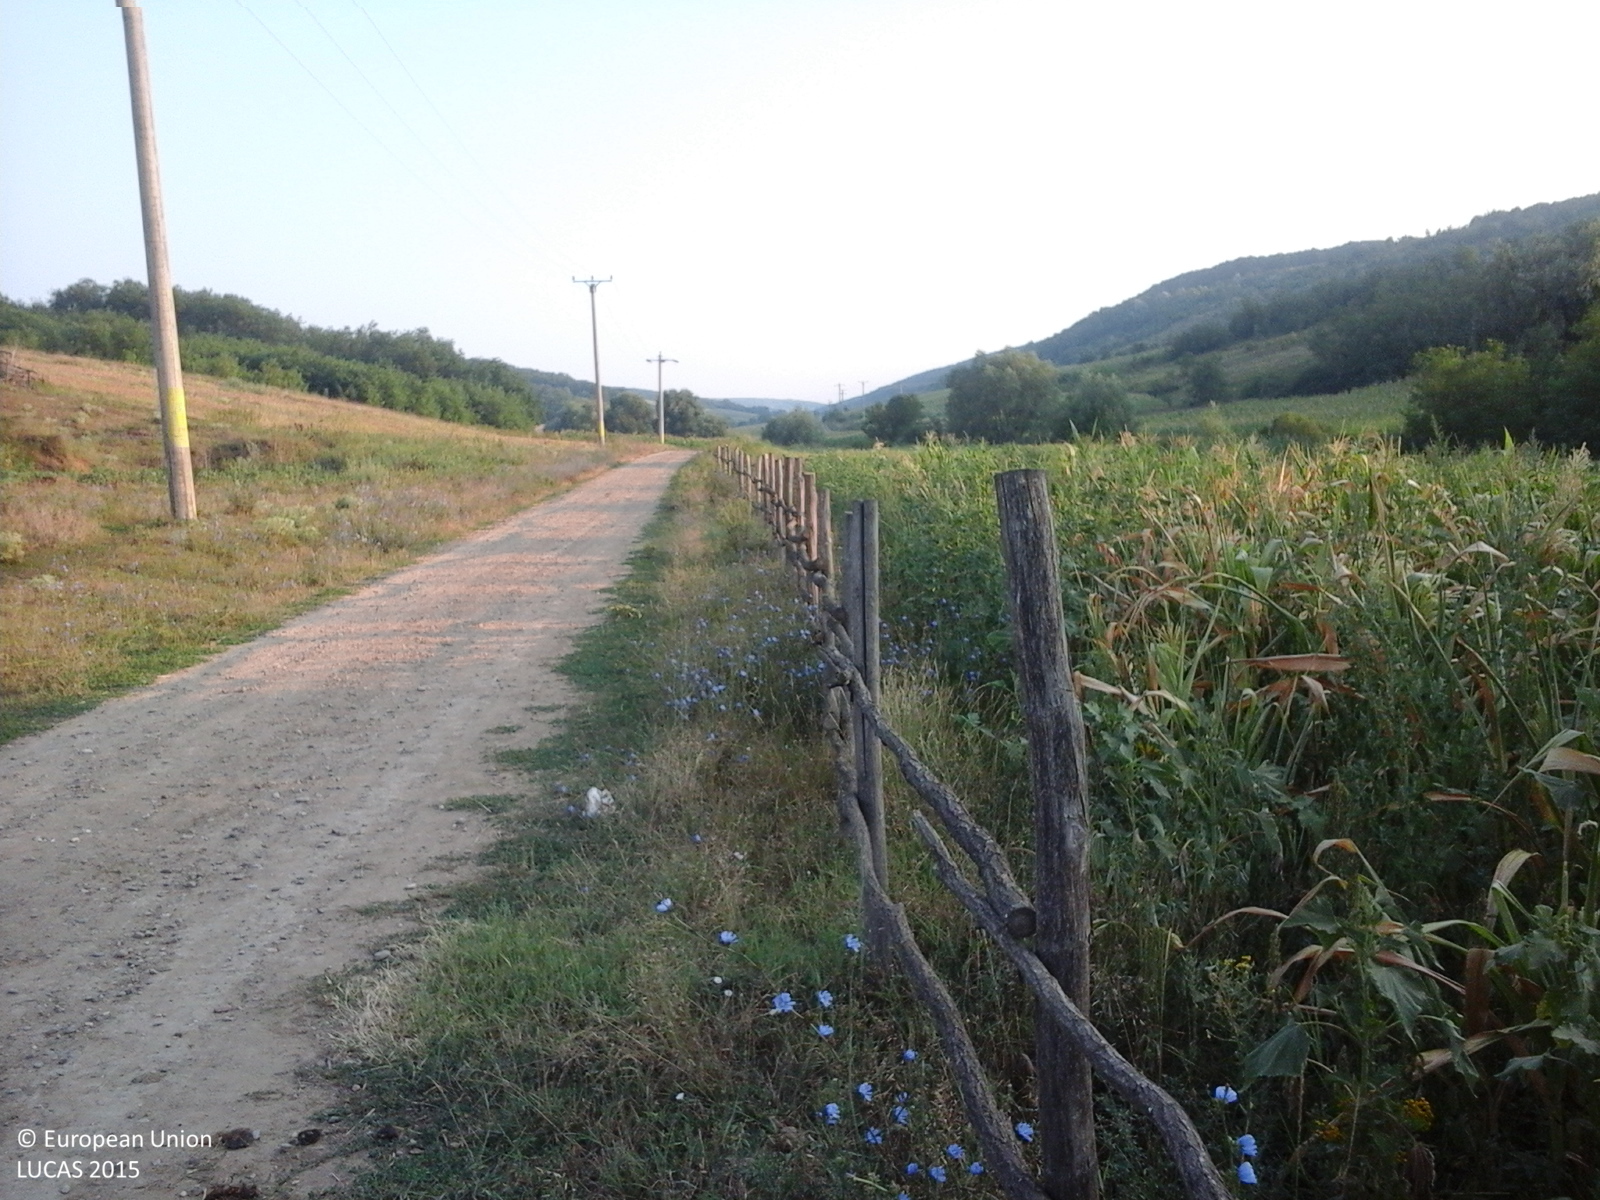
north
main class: Grassland
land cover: Spontaneously vegetated surfaces
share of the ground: > 75 %
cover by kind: herbaceous plants 100 %
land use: Fallow land
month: July
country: RO
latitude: 46.4655
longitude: 27.6828
